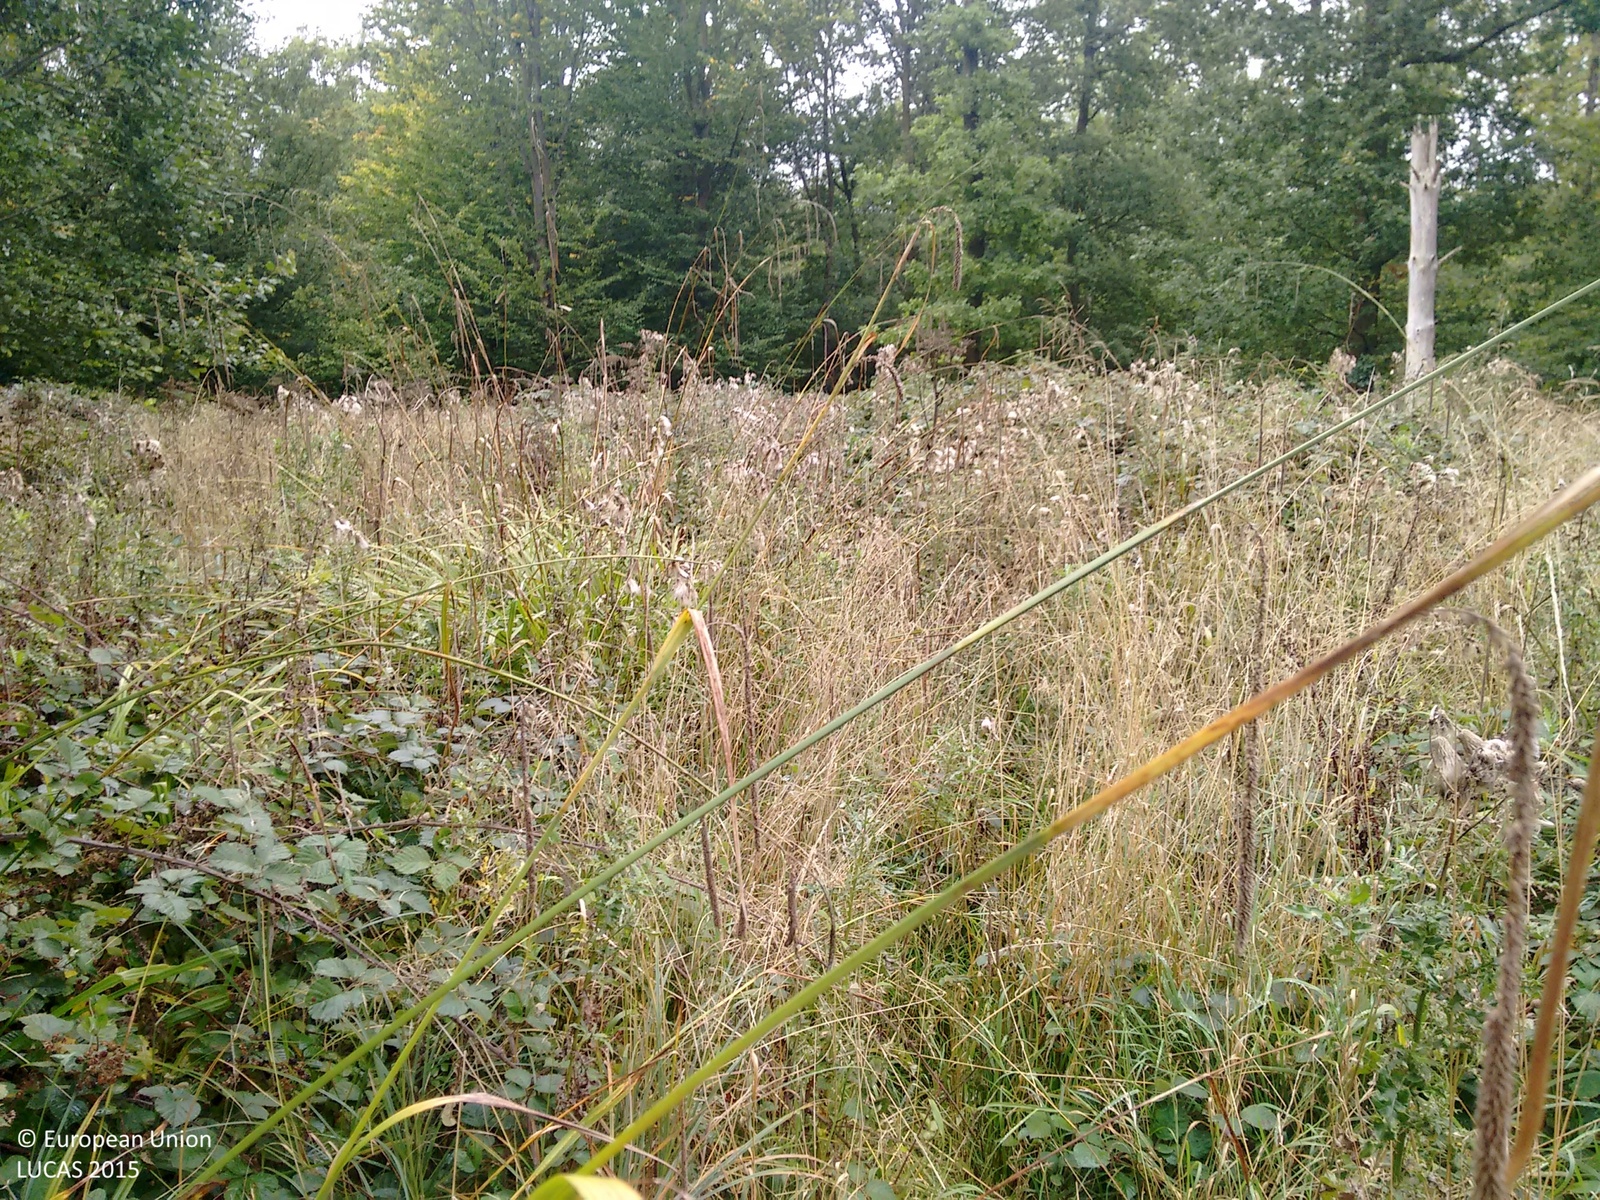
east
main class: Woodland
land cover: Broadleaved woodland
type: mesophytic deciduous forest
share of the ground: 25 - 50 %
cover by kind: shrubs 50 %, broadleaved forest trees 40 %, herbaceous plants 10 %
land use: Forestry
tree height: > 5 m
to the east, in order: Broadleaved woodland; Groves; Tracks; Grass margins; Groves; Broadleaved woodland; Grass margins; Tracks; Grass margins; Groves; Pine dominated mixed woodland
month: September
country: GB
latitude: 51.9784
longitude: 0.2886
